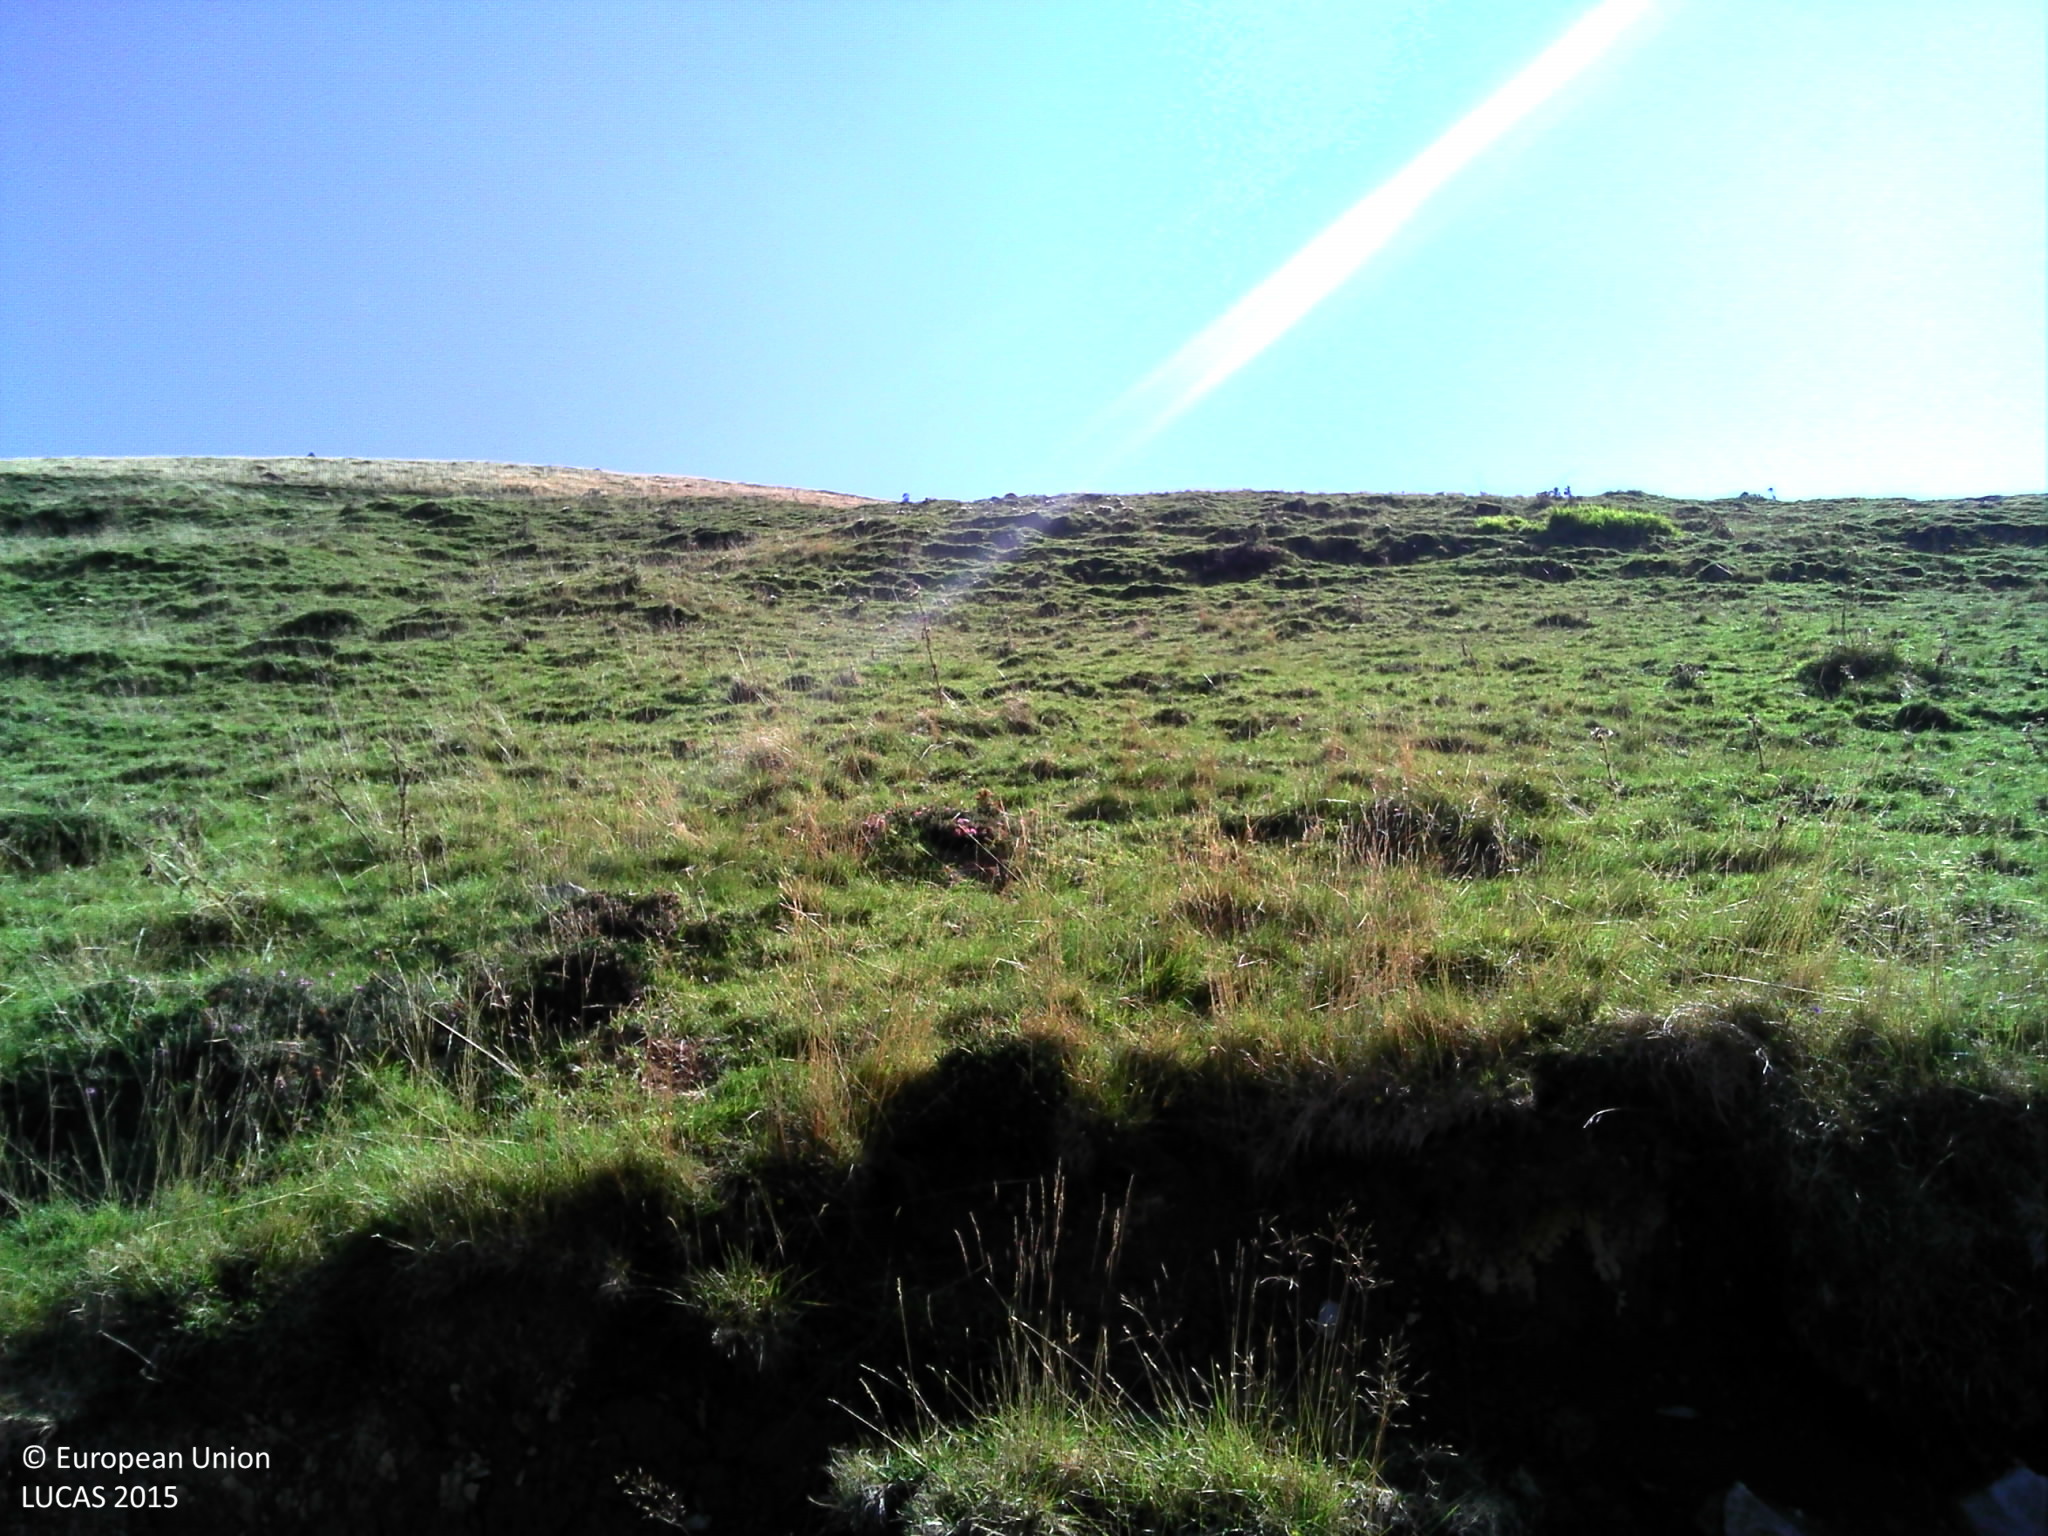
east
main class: Grassland
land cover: Spontaneously vegetated surfaces
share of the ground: 50 - 75 %
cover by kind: herbaceous plants 55 %, unconsolidated bare surface 30 %, consolidated bare surface 10 %, shrubs 5 %
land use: Agriculture (excluding fallow land and kitchen gardens)
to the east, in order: Spontaneously vegetated surfaces; Grassland without tree/shrub cover; Paved roads, cycling and walking lanes; Ditches and canals; Rocks and stones; Grassland without tree/shrub cover; Paved roads, cycling and walking lanes; Grass margins; Ditches and canals; Rocks and stones; Grassland without tree/shrub cover
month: September
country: FR
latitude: 43.0010
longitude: -0.9887
